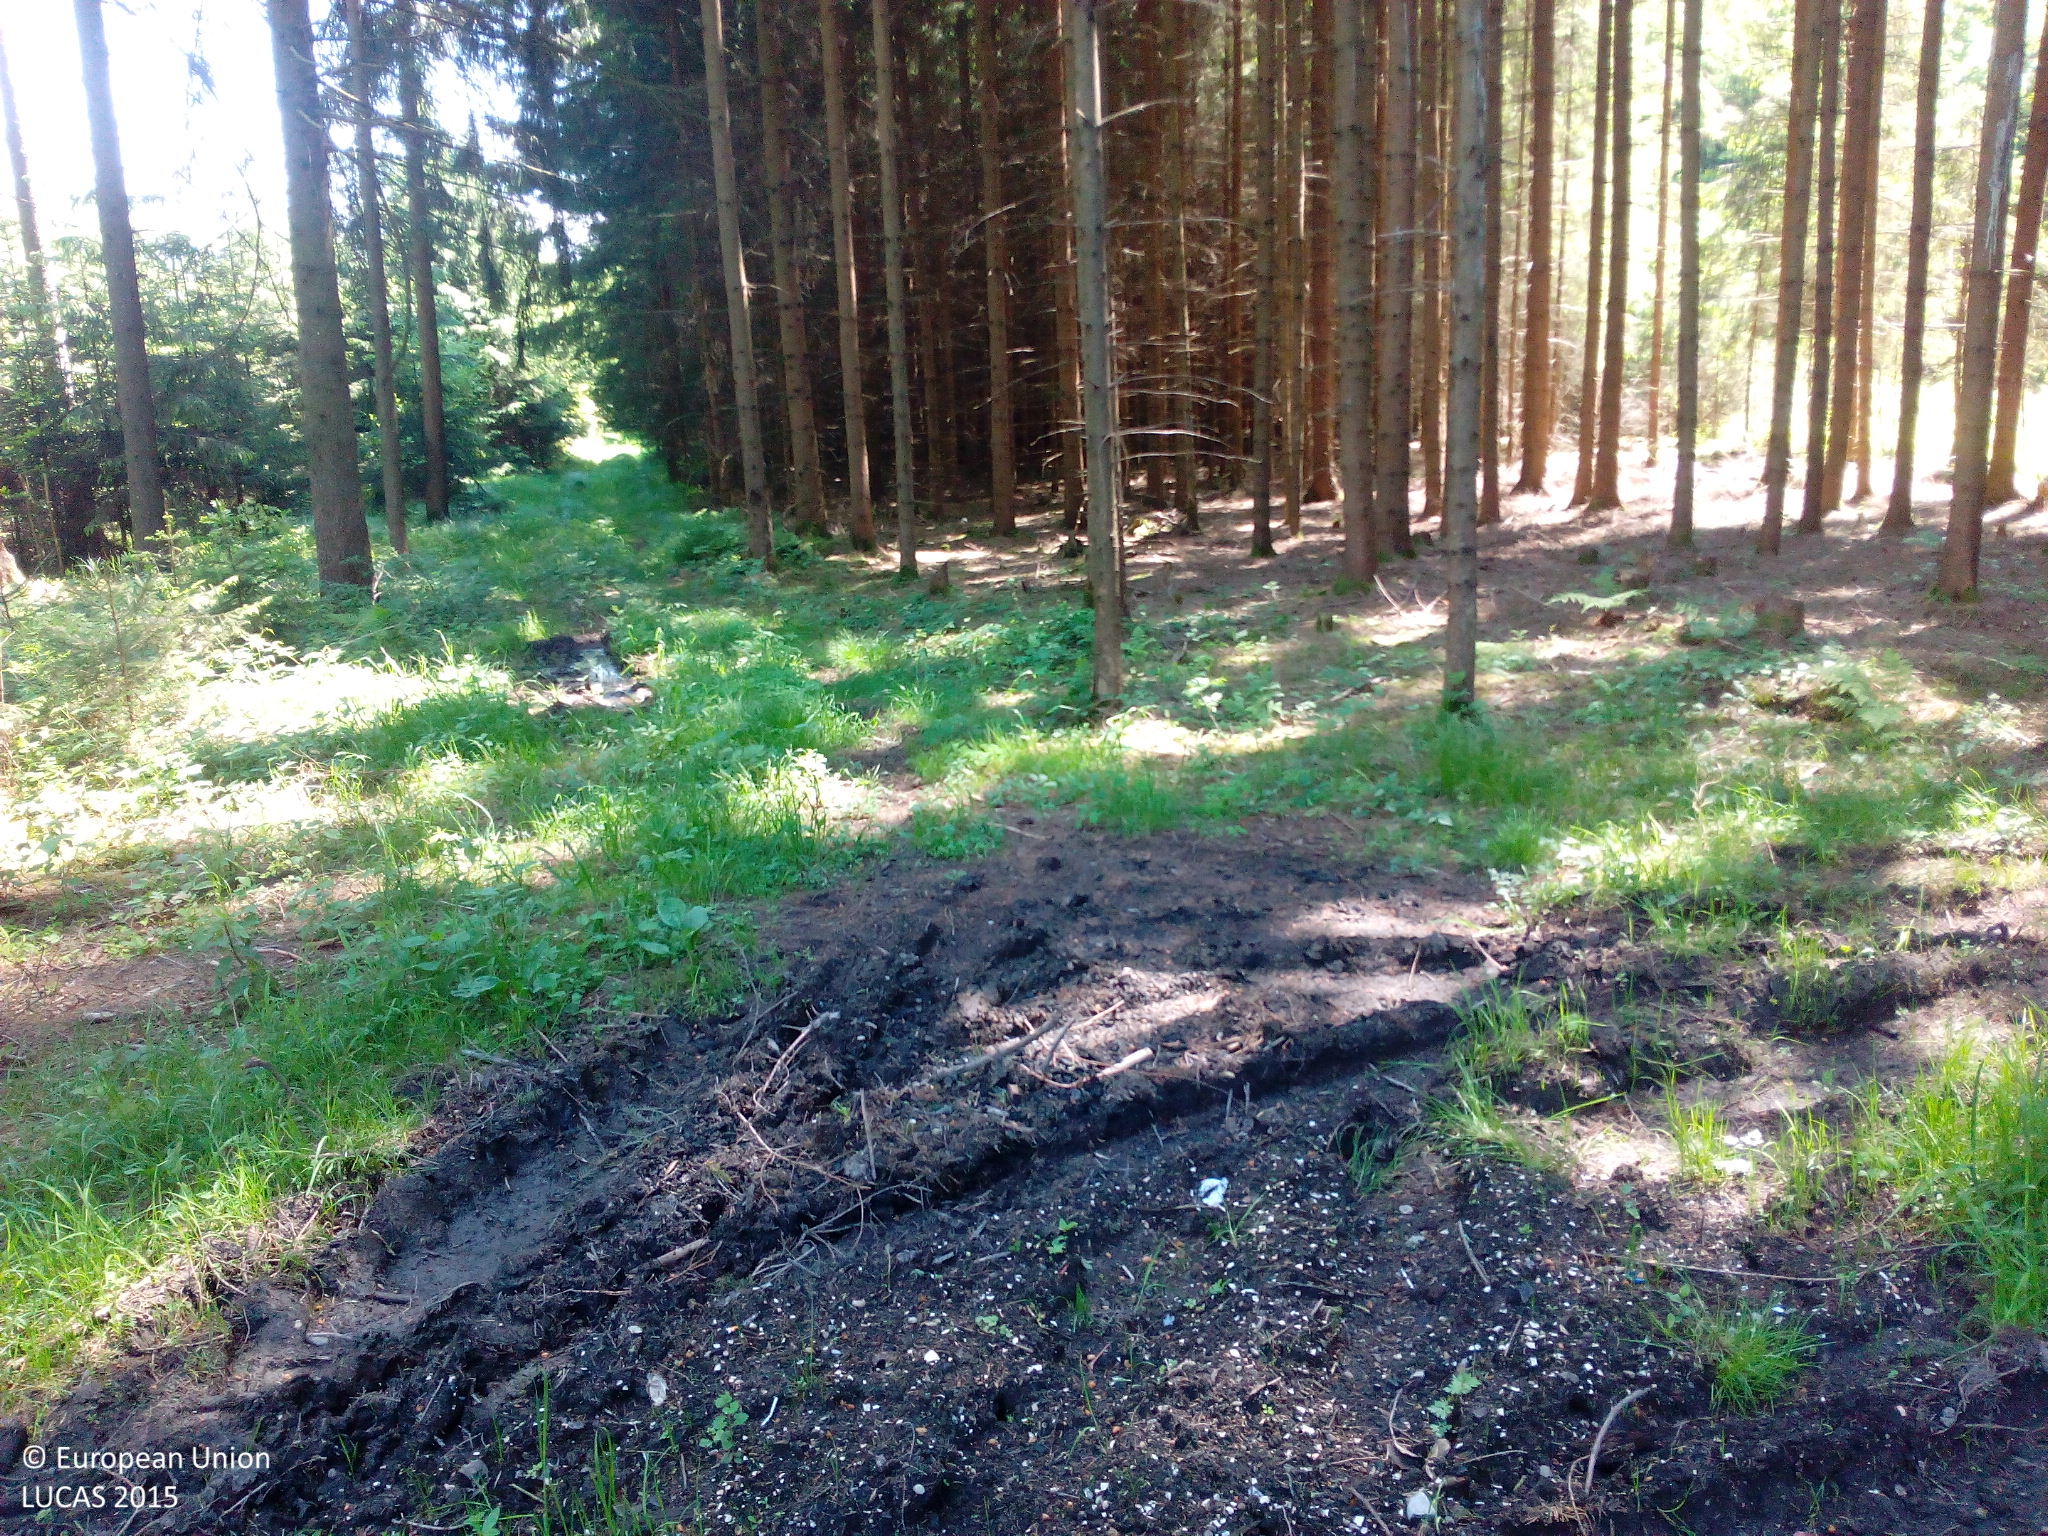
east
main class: Woodland
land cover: Spruce dominated coniferous woodland
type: hemiboreal forest and nemoral coniferous forest and mixed broadleaved-coniferous forest
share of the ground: > 75 %
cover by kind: coniferous forest trees 100 %
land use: Forestry
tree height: > 5 m
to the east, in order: Spruce dominated coniferous woodland; Tracks; Spruce dominated coniferous woodland; Tracks; Spruce dominated coniferous woodland; Fences; Grassland without tree/shrub cover; Artificial constructions in urban areas
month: June
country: DE
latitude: 47.8093
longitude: 10.2535
